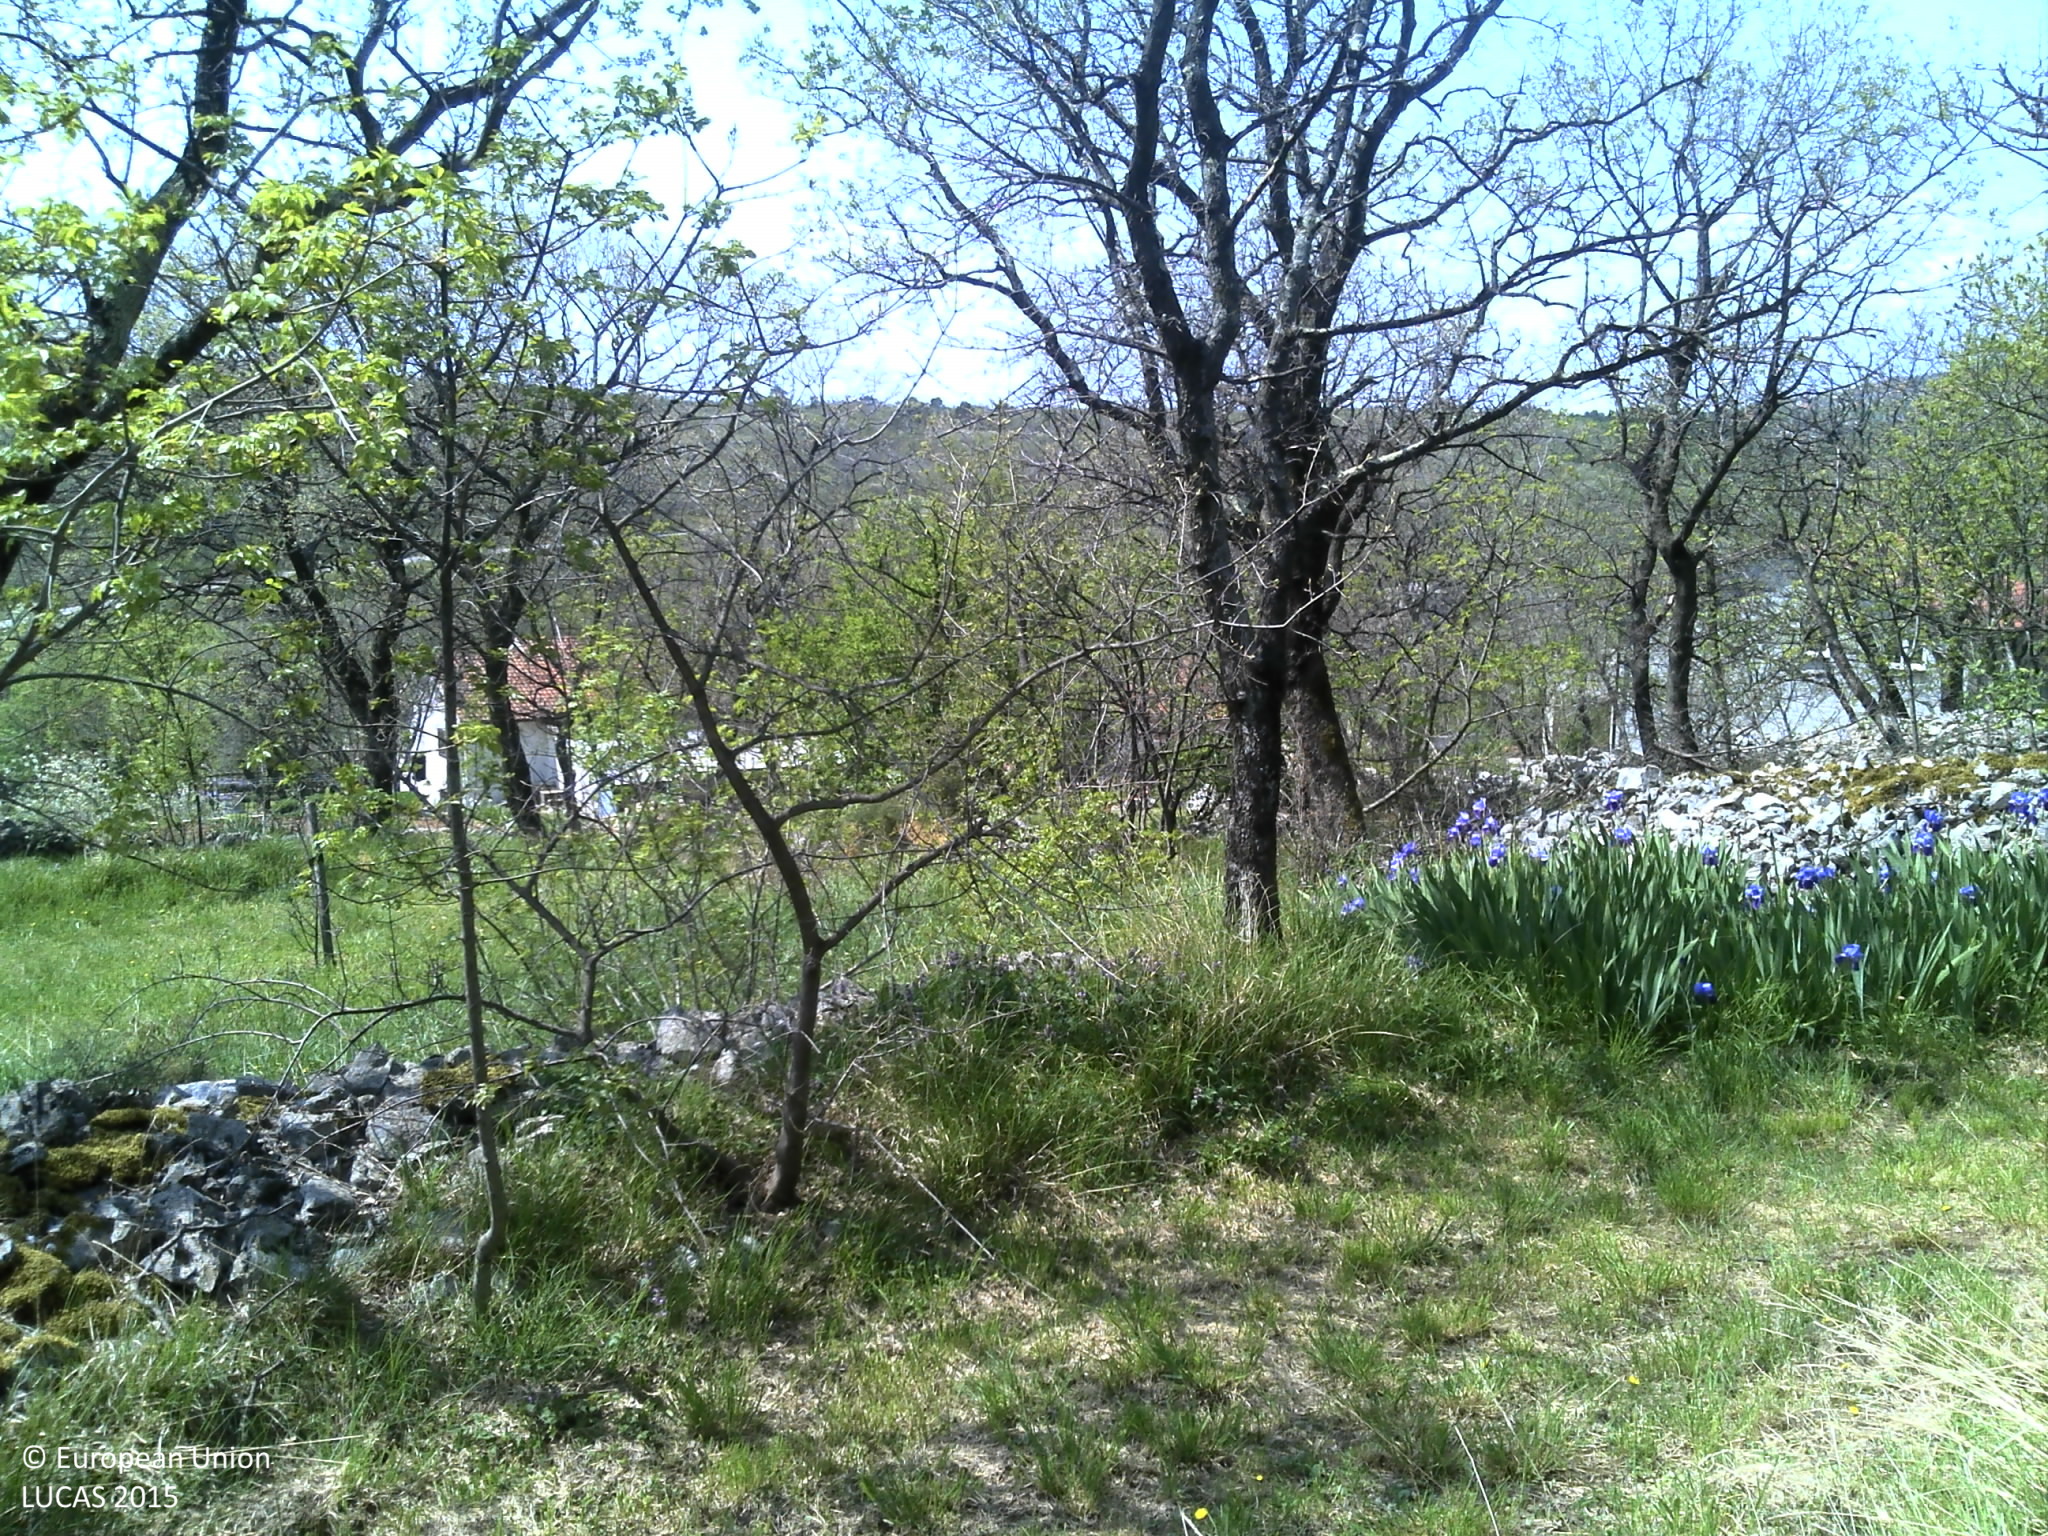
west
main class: Grassland
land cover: Grassland with sparse tree/shrub cover
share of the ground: > 75 %
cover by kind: herbaceous plants 70 %, shrubs 10 %, broadleaved forest trees 5 %
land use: Abandoned areas
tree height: < 5 m
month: April
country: HR
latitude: 45.3162
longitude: 14.5489
